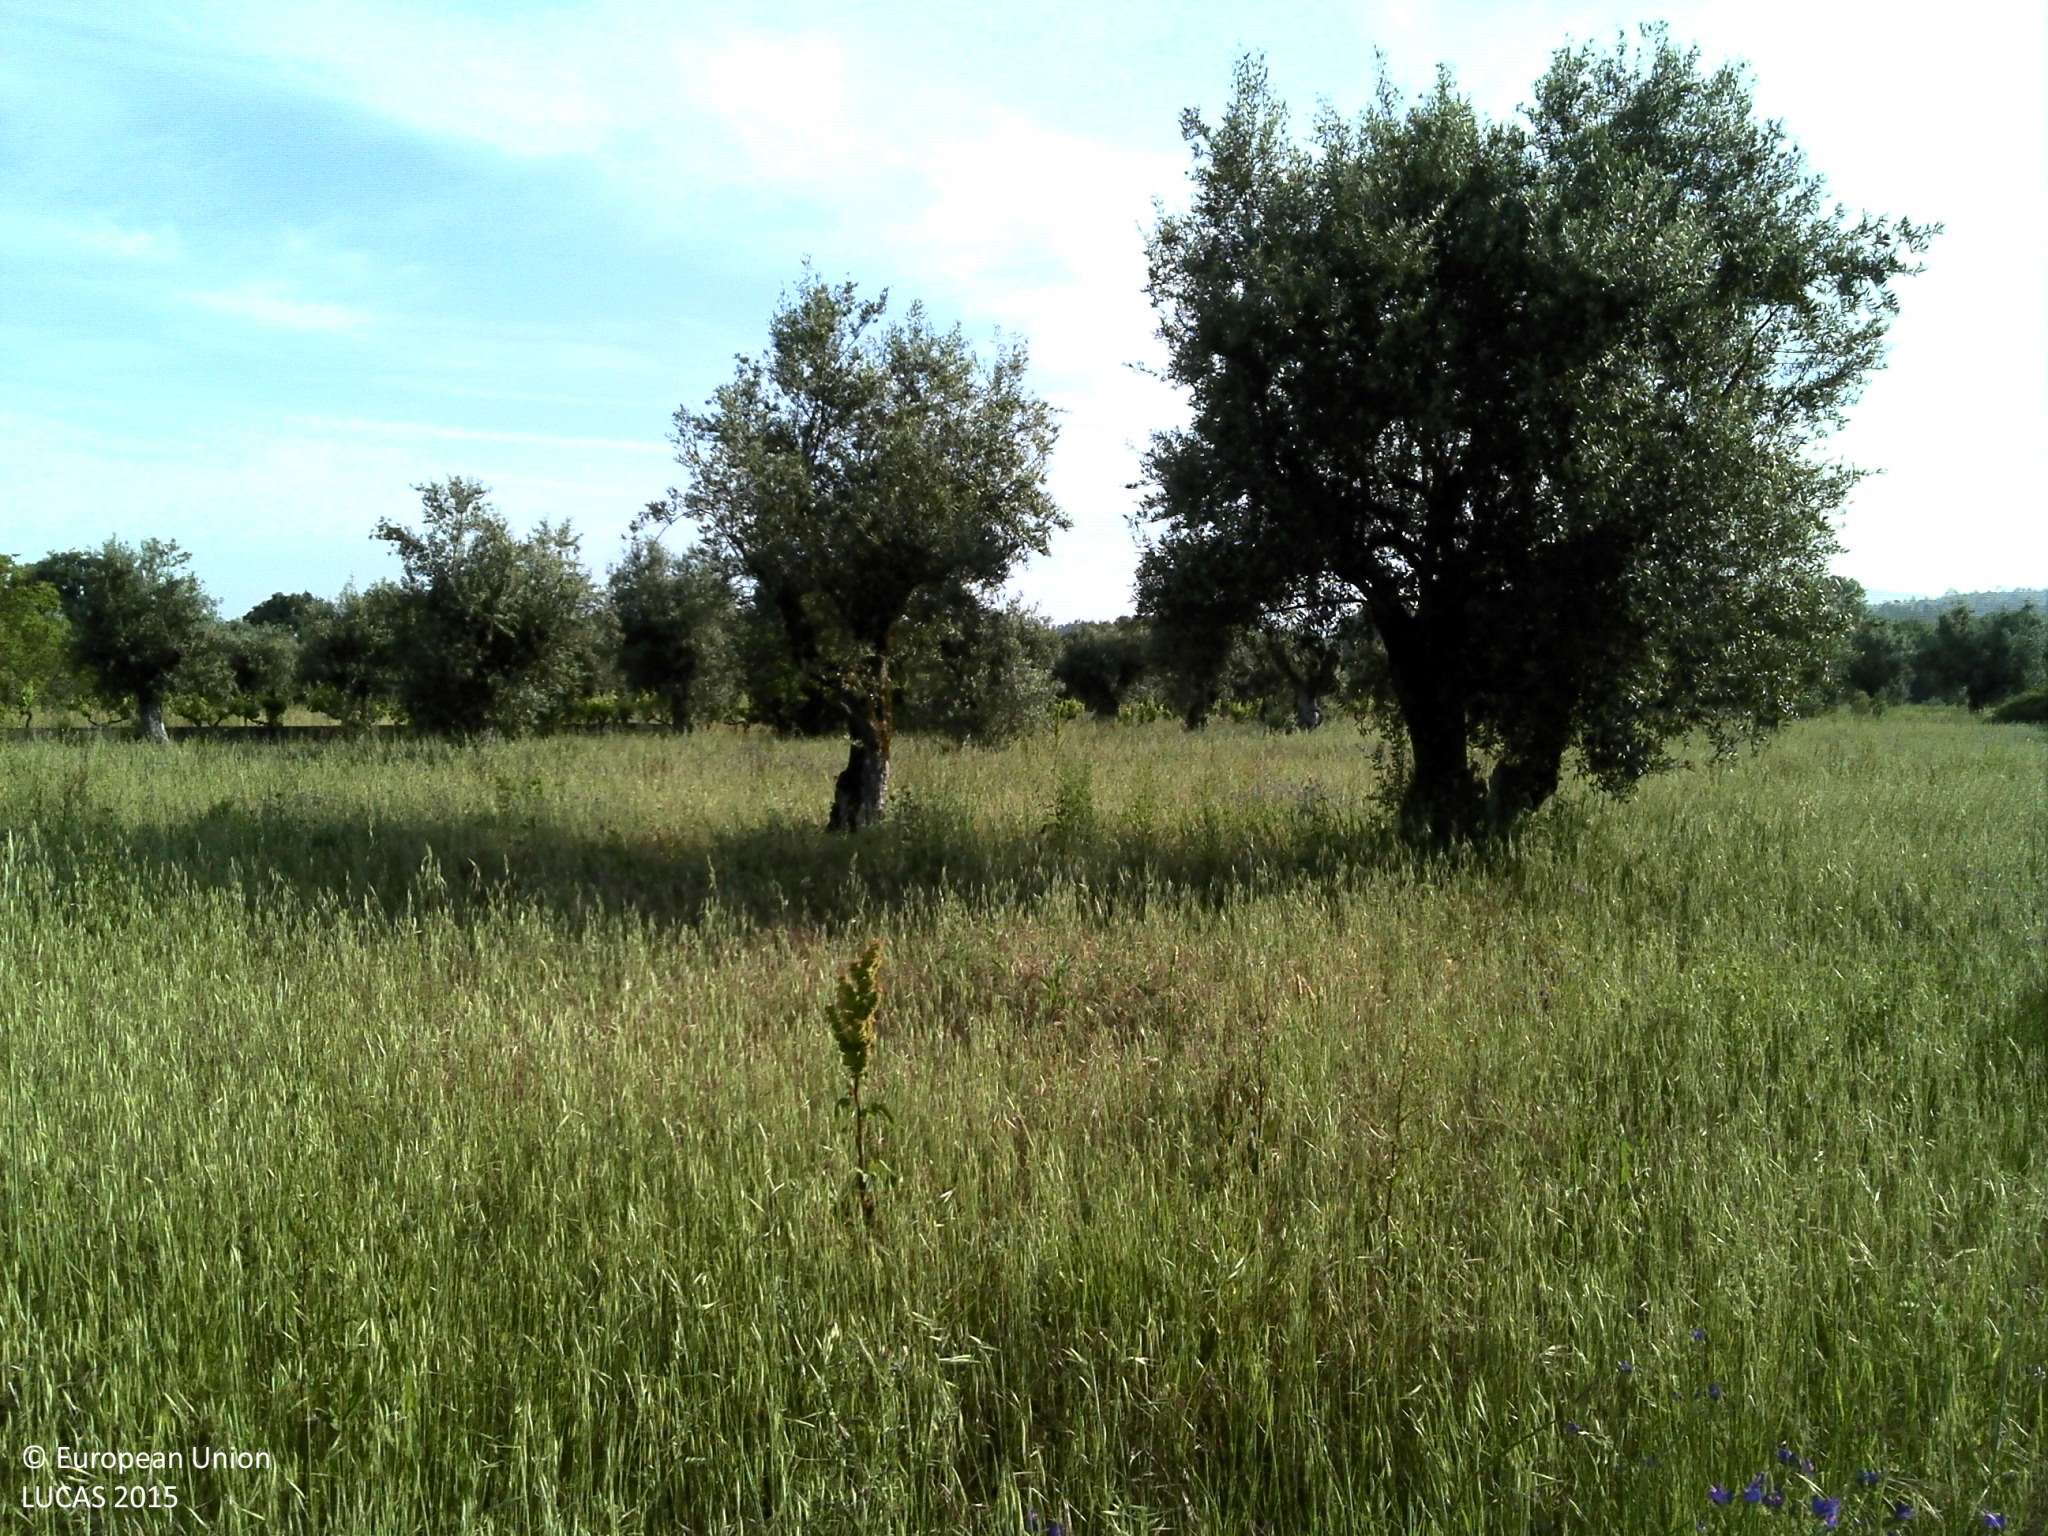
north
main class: Cropland
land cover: Oats
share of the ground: > 75 %
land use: Agriculture (excluding fallow land and kitchen gardens)
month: May
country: PT
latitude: 39.7740
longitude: -8.4646
